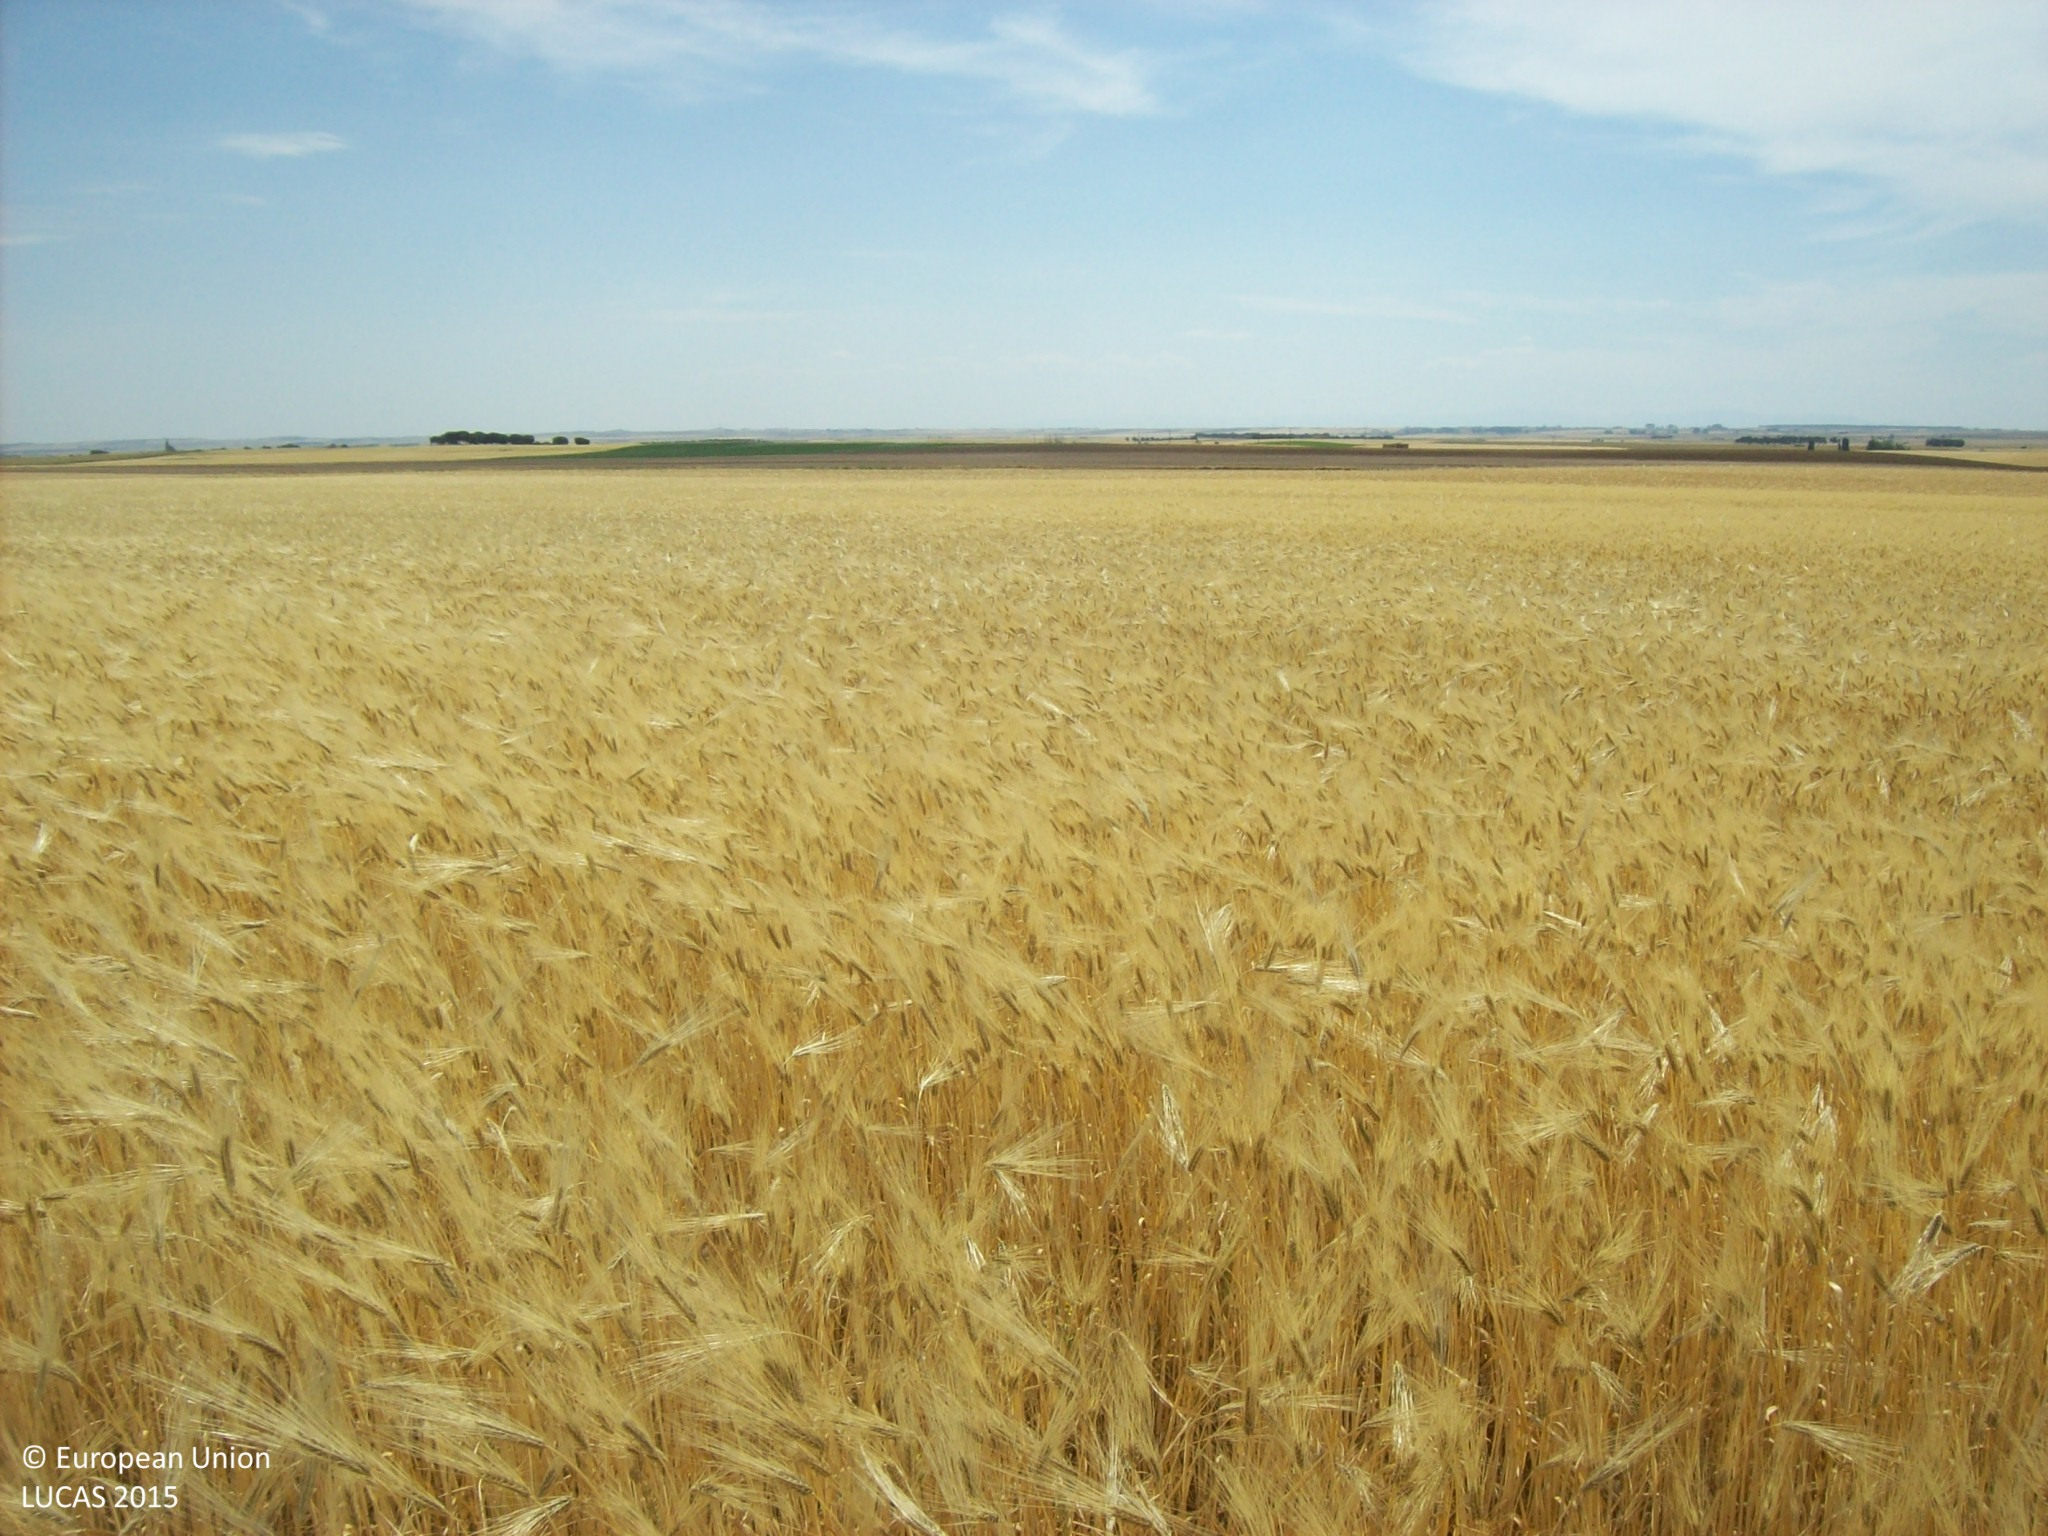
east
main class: Cropland
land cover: Barley
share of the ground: > 75 %
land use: Agriculture (excluding fallow land and kitchen gardens)
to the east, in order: Barley
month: June
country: ES
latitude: 41.0318
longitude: -5.0171
